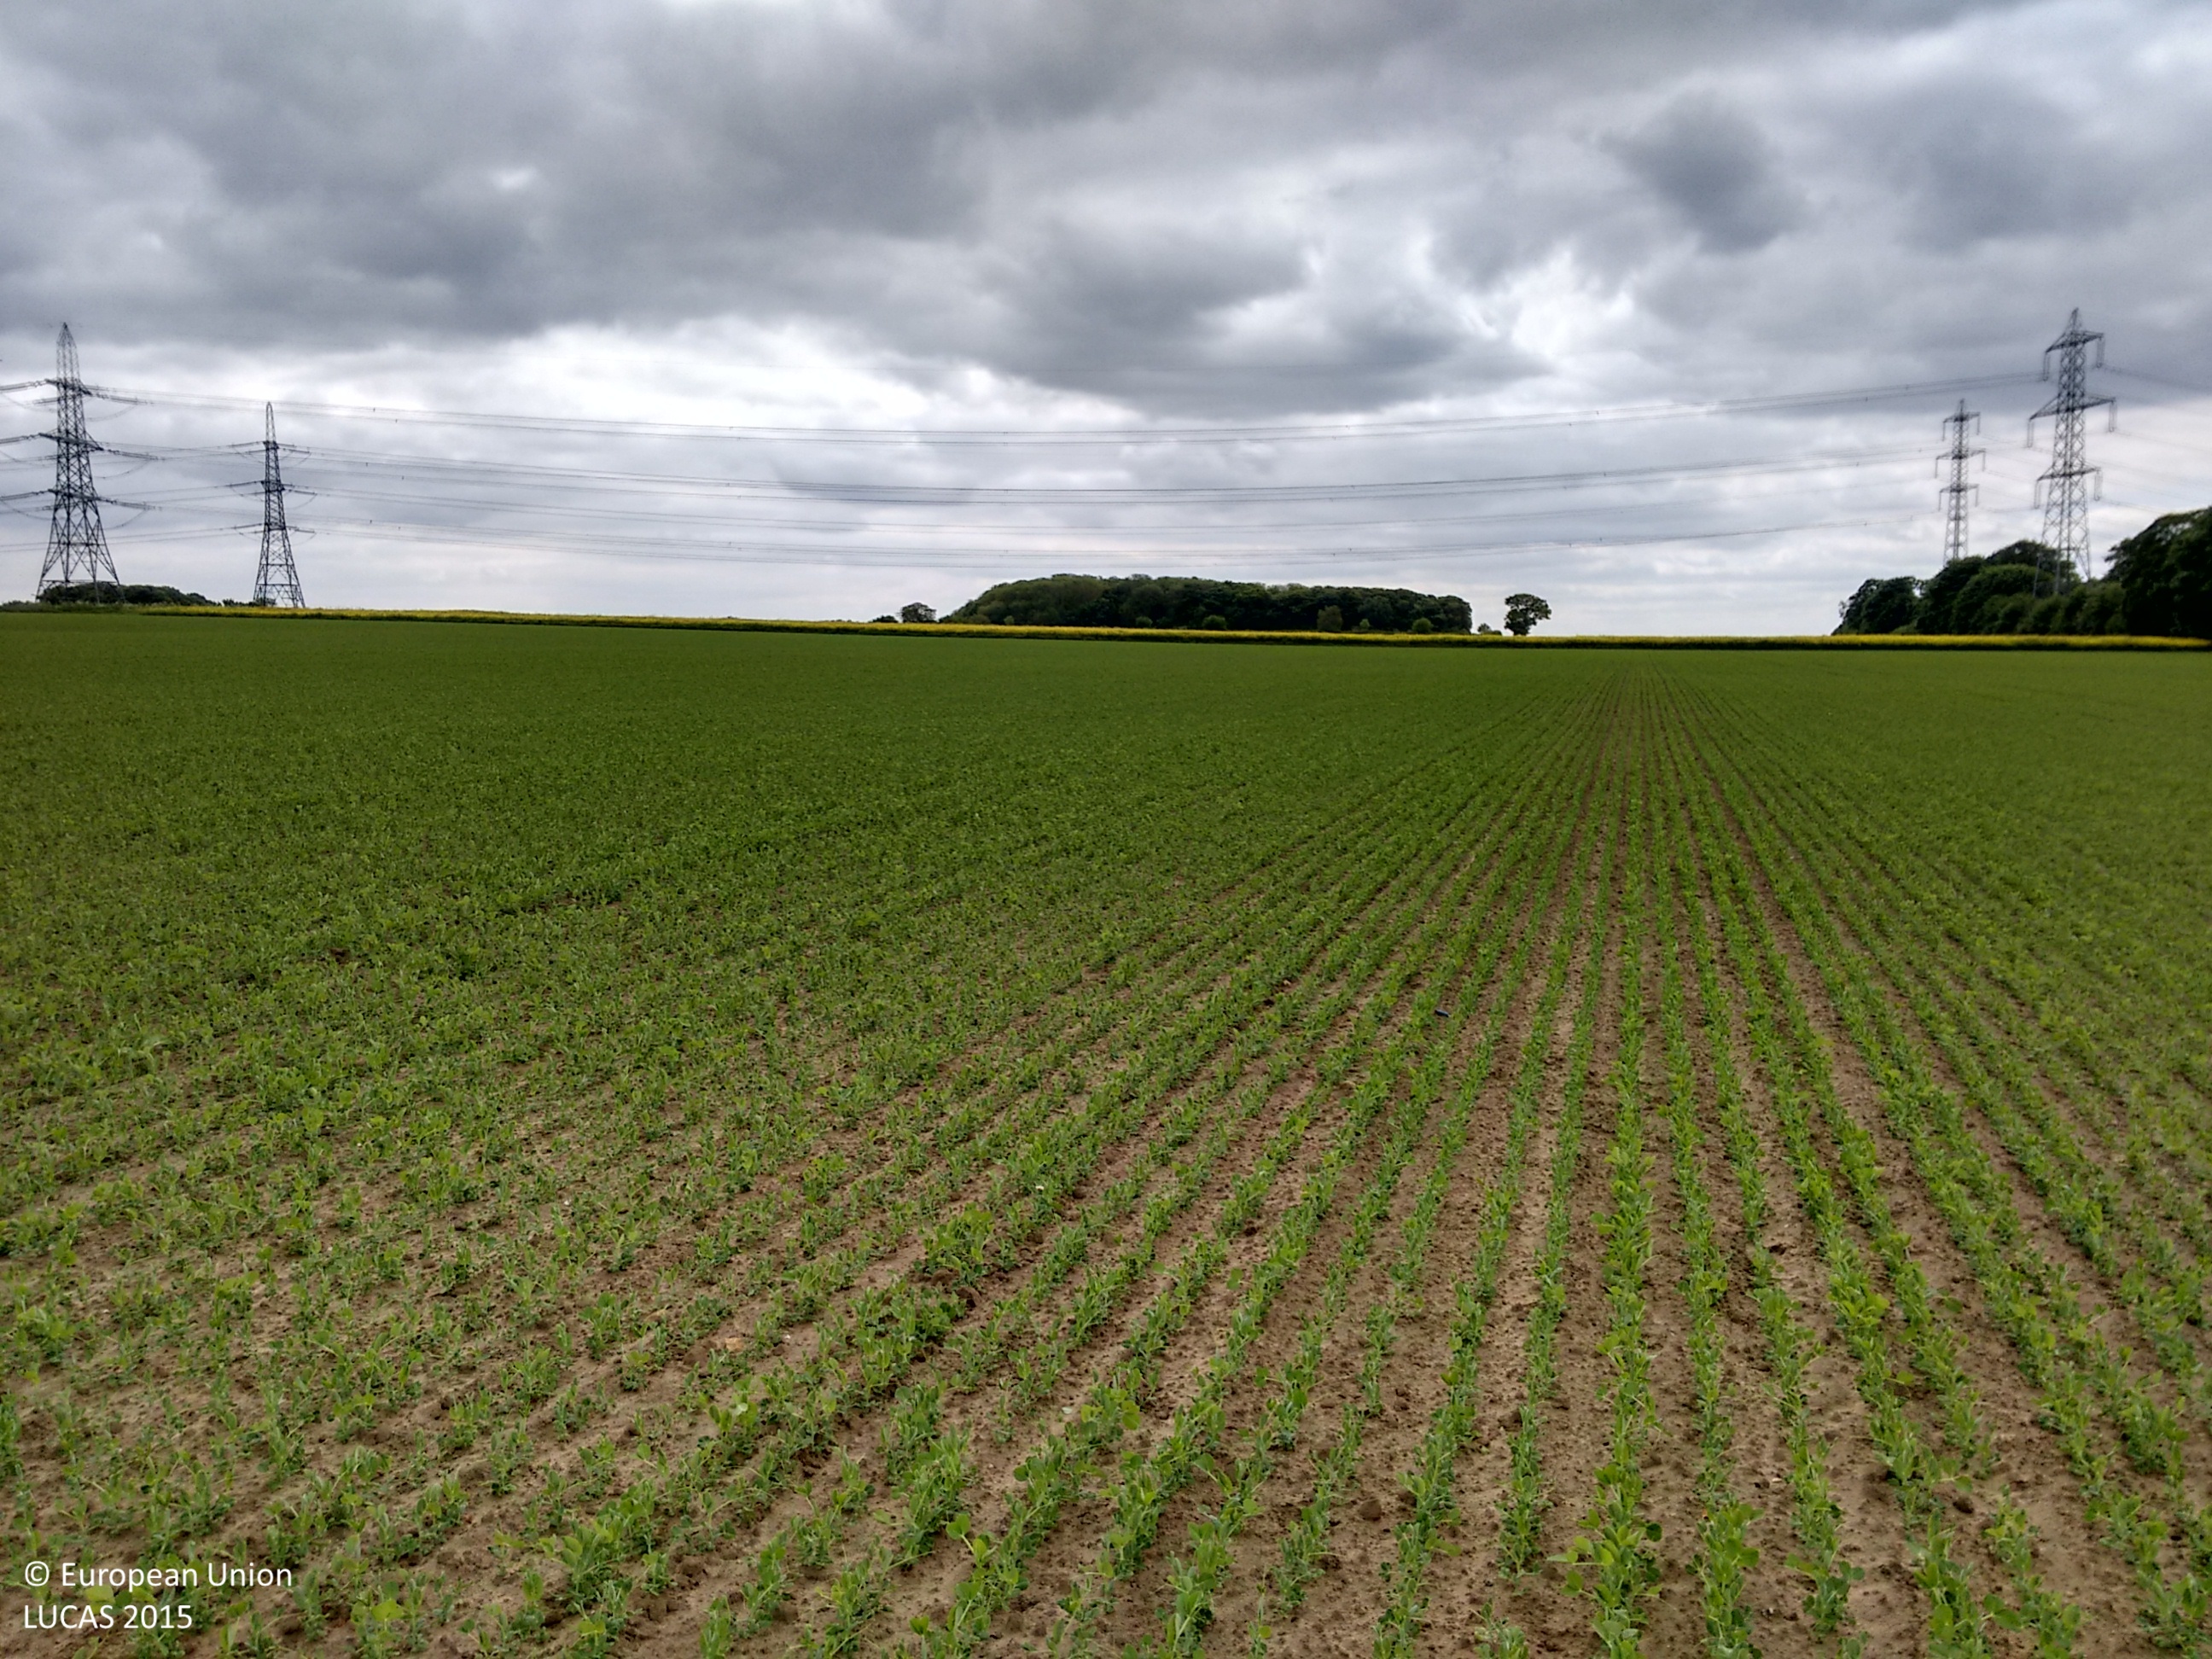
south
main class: Cropland
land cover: Dry pulses
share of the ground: 25 - 50 %
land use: Agriculture (excluding fallow land and kitchen gardens)
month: May
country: GB
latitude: 53.6720
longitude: -0.6803
